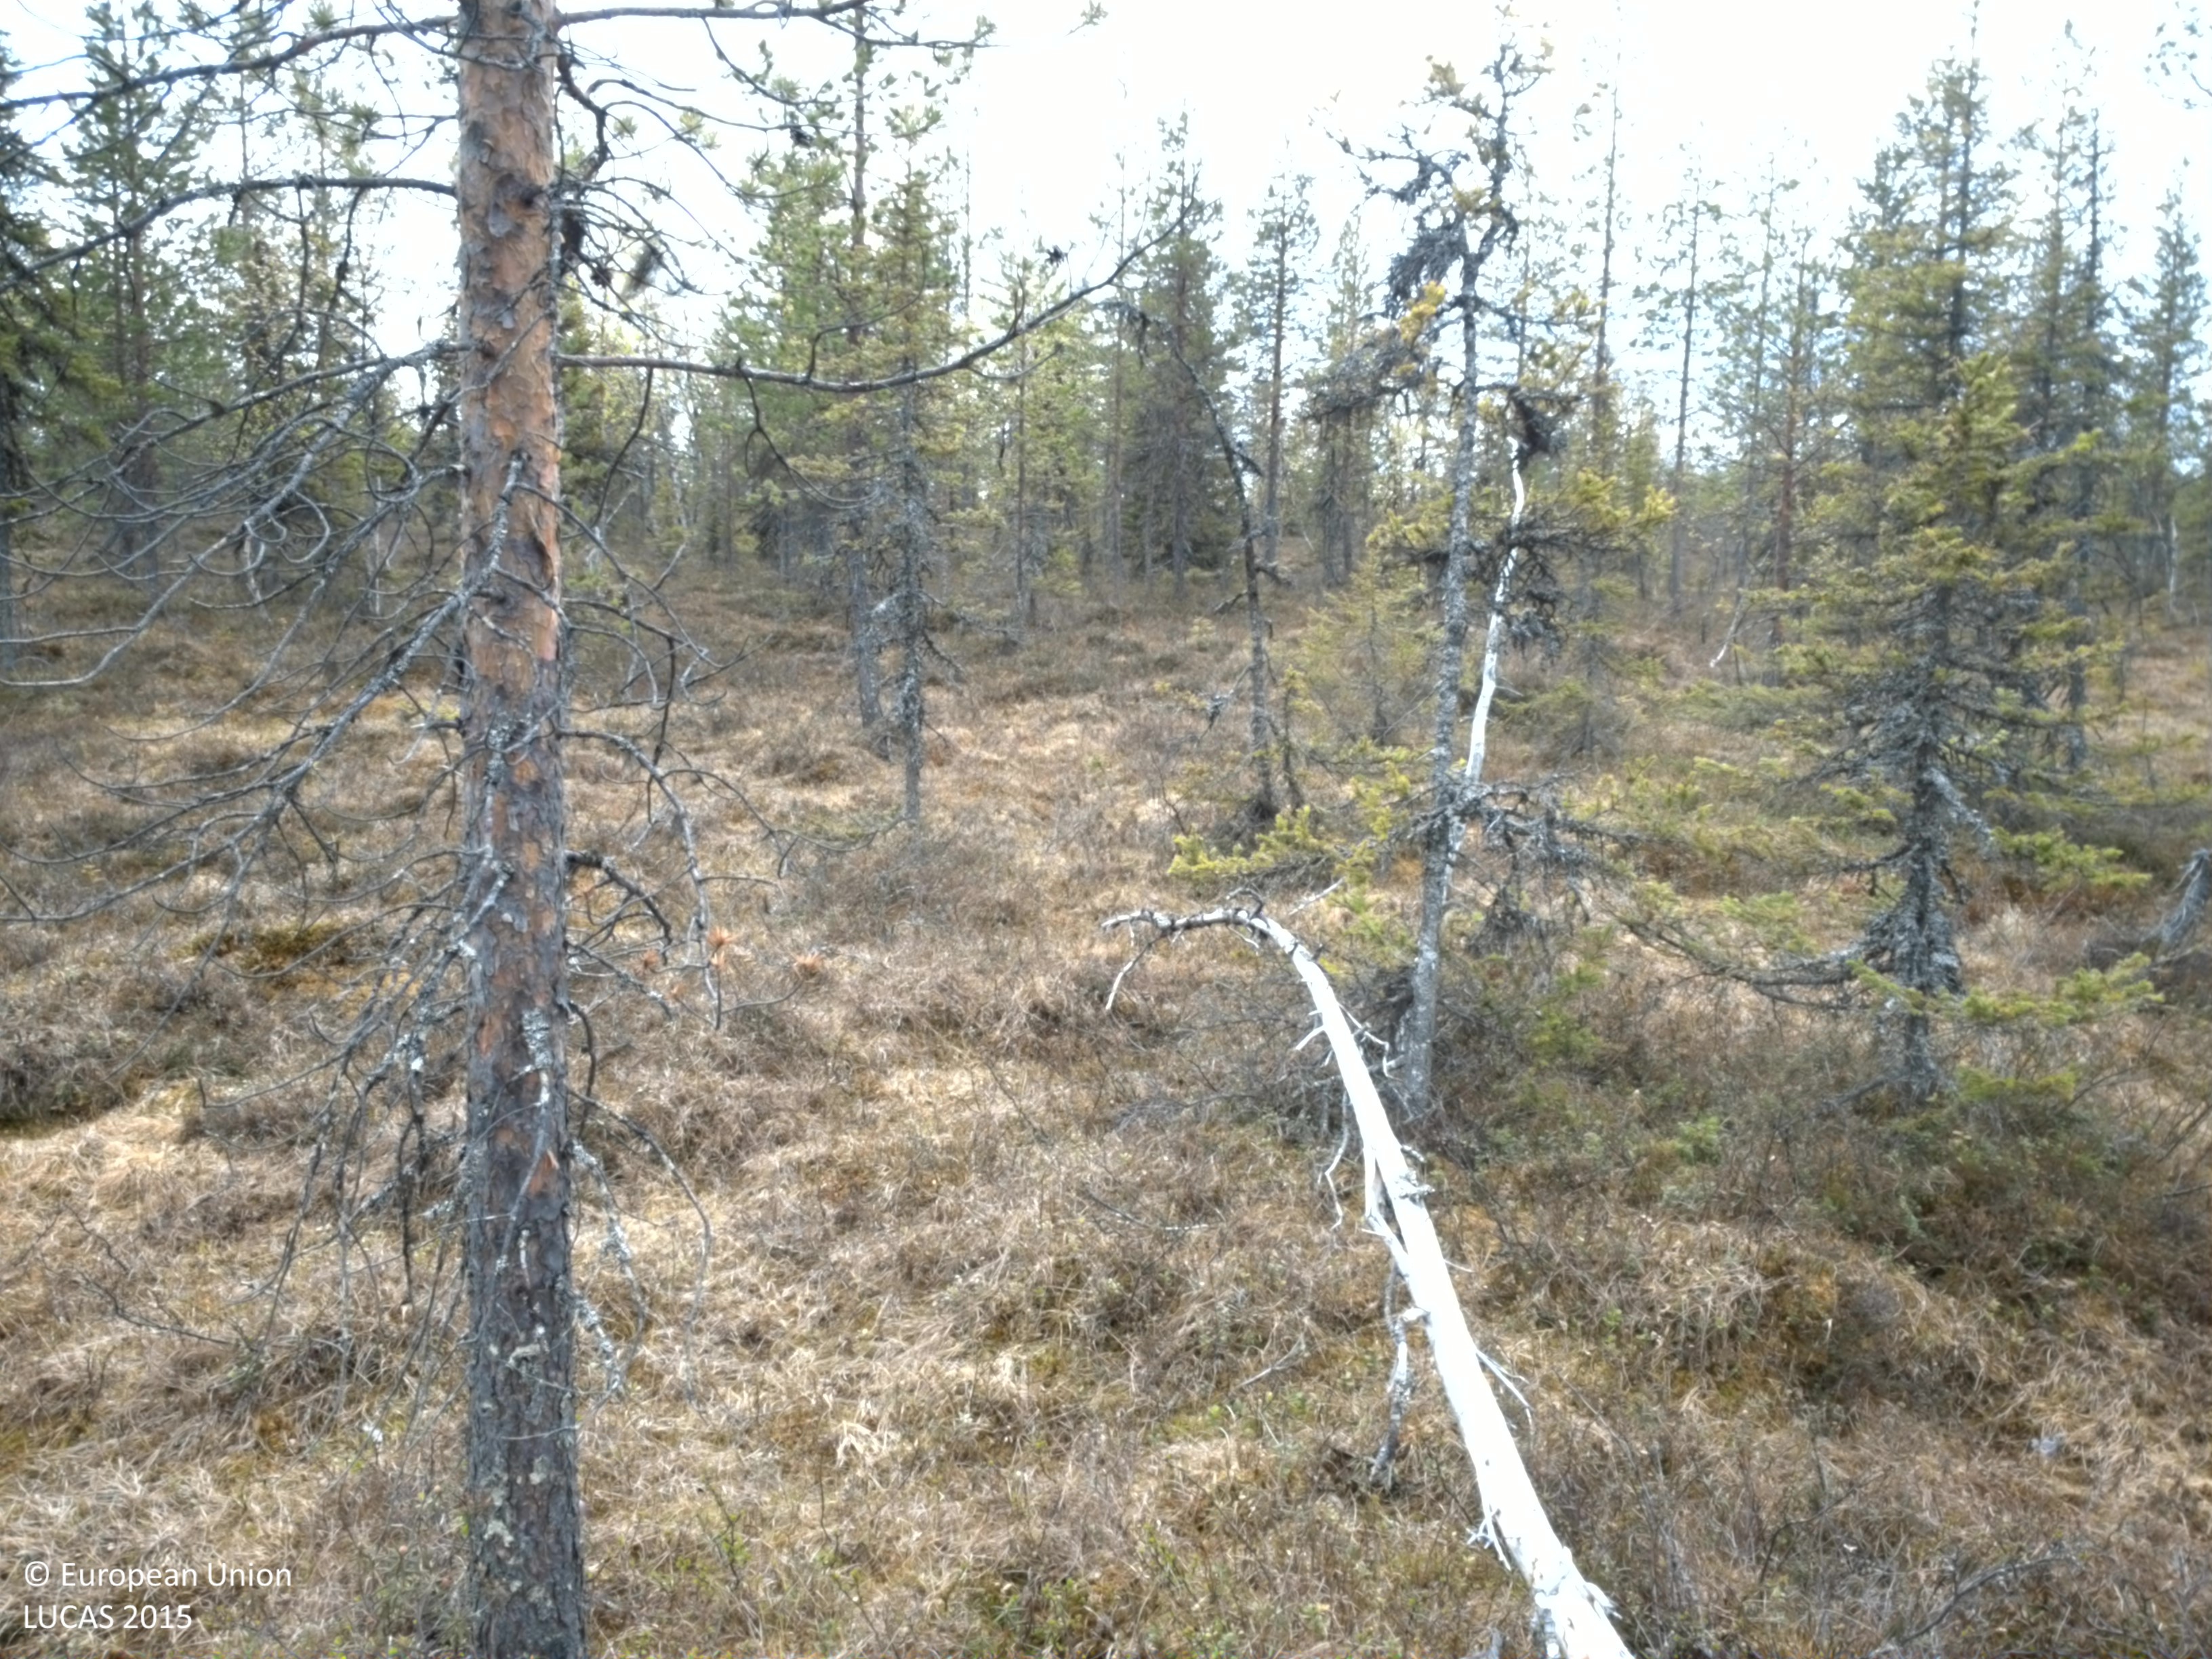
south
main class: Woodland
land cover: Pine dominated coniferous woodland
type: mire and swamp forests
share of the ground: 10 - 25 %
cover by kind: shrubs 50 %, herbaceous plants 35 %, coniferous forest trees 15 %
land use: Semi-natural and natural areas not in use
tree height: > 5 m
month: June
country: SE
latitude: 66.0823
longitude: 18.8192
